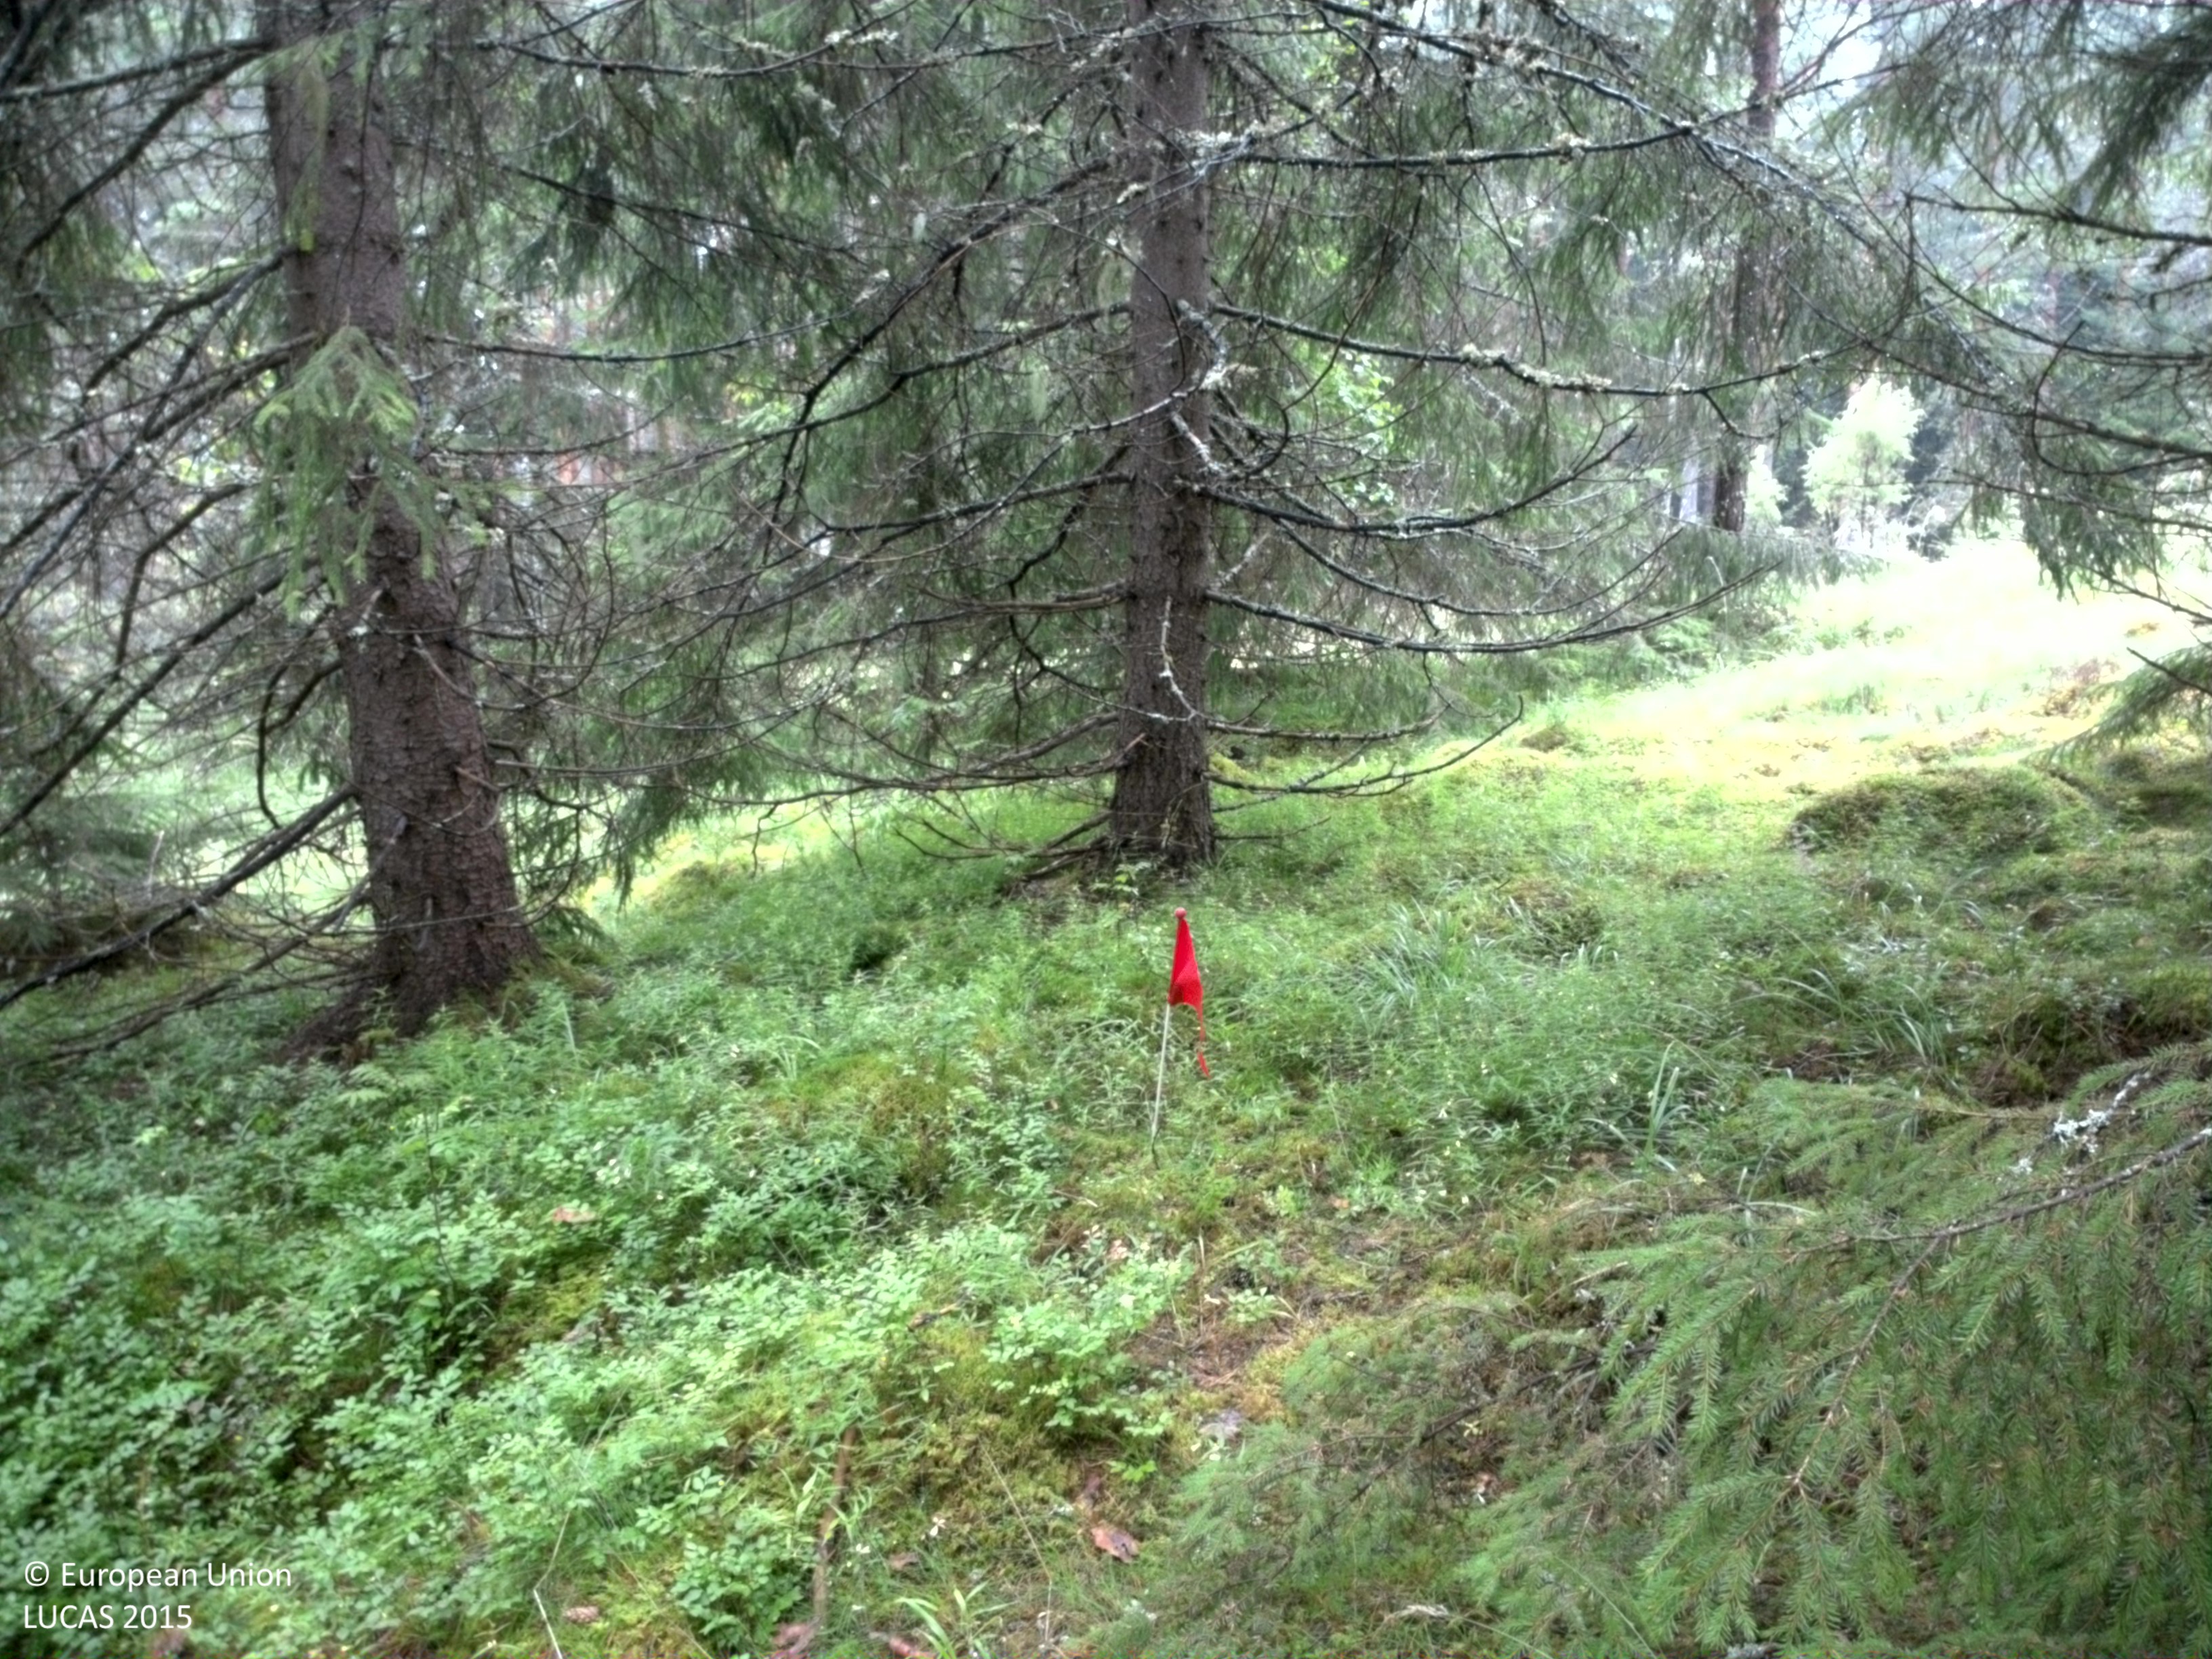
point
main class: Woodland
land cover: Spruce dominated coniferous woodland
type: boreal forest
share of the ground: 50 - 75 %
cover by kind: coniferous forest trees 55 %, shrubs 25 %, lichens and mosses 15 %, broadleaved forest trees 5 %
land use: Forestry
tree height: > 5 m
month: August
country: SE
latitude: 59.4585
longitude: 13.2562
